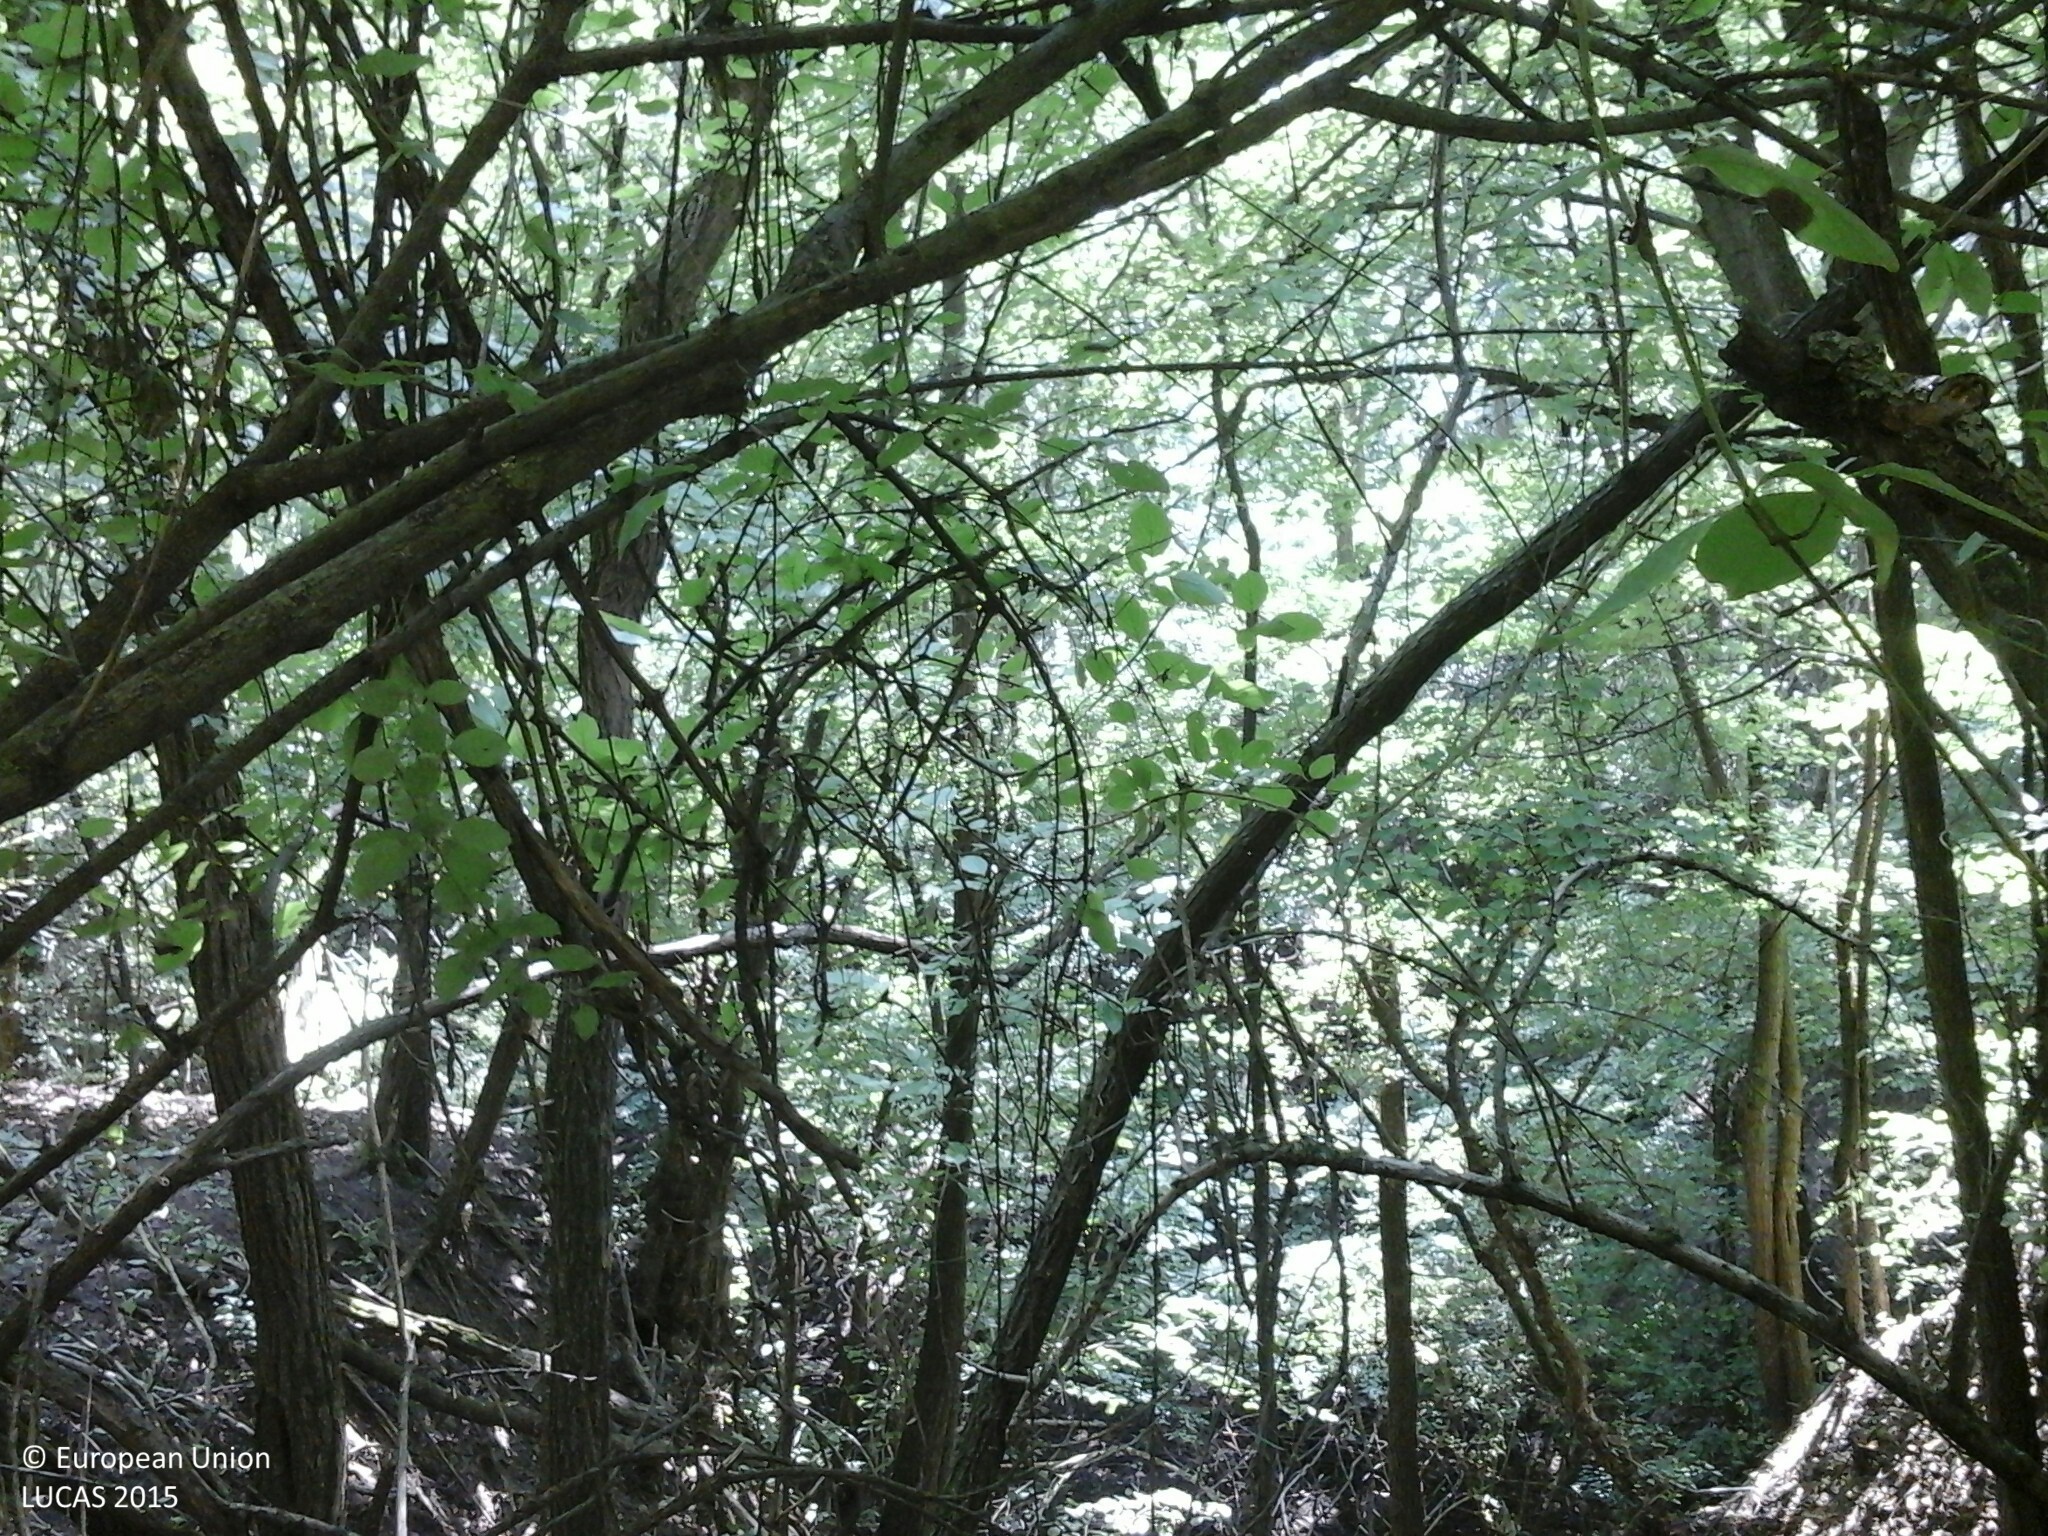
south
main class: Woodland
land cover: Broadleaved woodland
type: acidophilous oak and oak-birch forest
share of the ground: > 75 %
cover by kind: broadleaved forest trees 90 %, shrubs 10 %
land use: Forestry
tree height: > 5 m
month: August
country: HU
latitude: 48.1302
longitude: 20.3919
